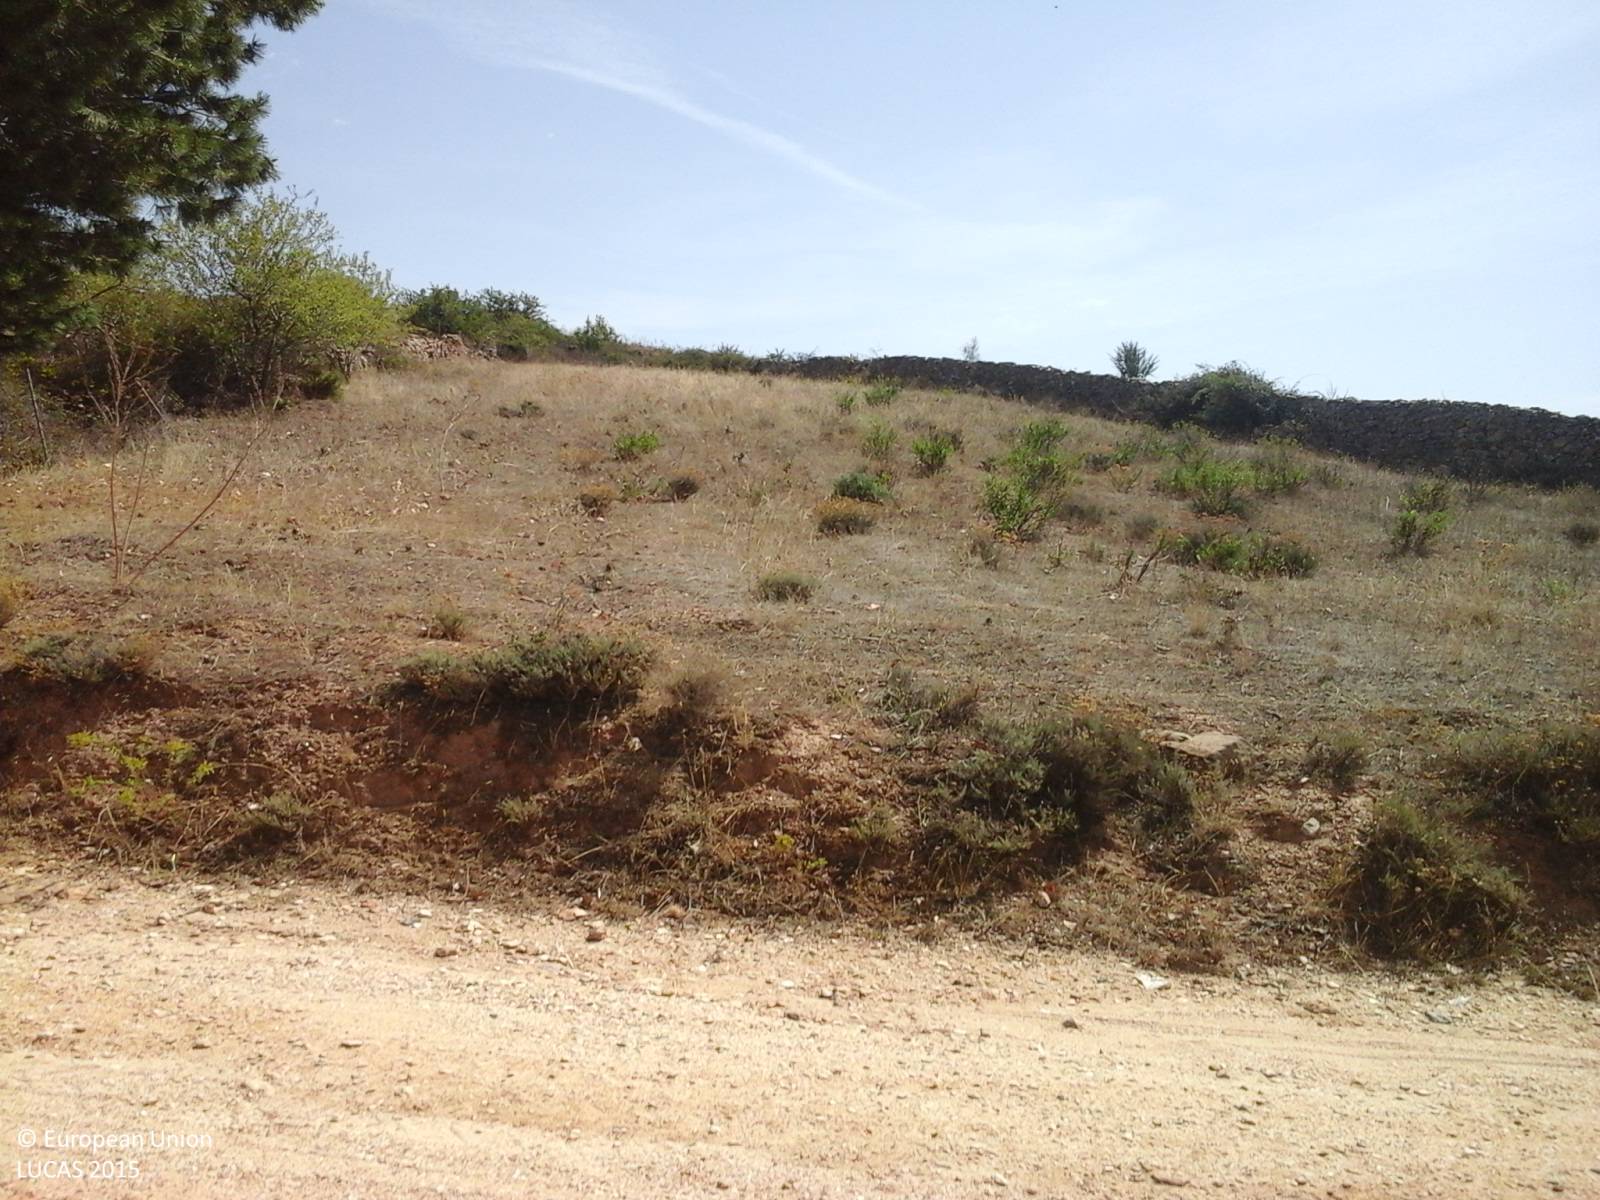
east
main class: Cropland
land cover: Vineyards
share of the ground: > 75 %
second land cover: Spontaneously vegetated surfaces
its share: > 75 %
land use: Agriculture (excluding fallow land and kitchen gardens)
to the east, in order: Vineyards; Spontaneously vegetated surfaces; Dry stone walls; Vineyards; Fences; Vineyards; Grassland without tree/shrub cover; Broadleaved woodland; Managed hedges; Fences; Vineyards; Fences; Managed hedges; Grassland without tree/shrub cover; Fences; Grassland without tree/shrub cover; Abandoned hedges; Grassland without tree/shrub cover; Tracks; Abandoned hedges
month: September
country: IT
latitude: 39.8118
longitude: 9.2450
